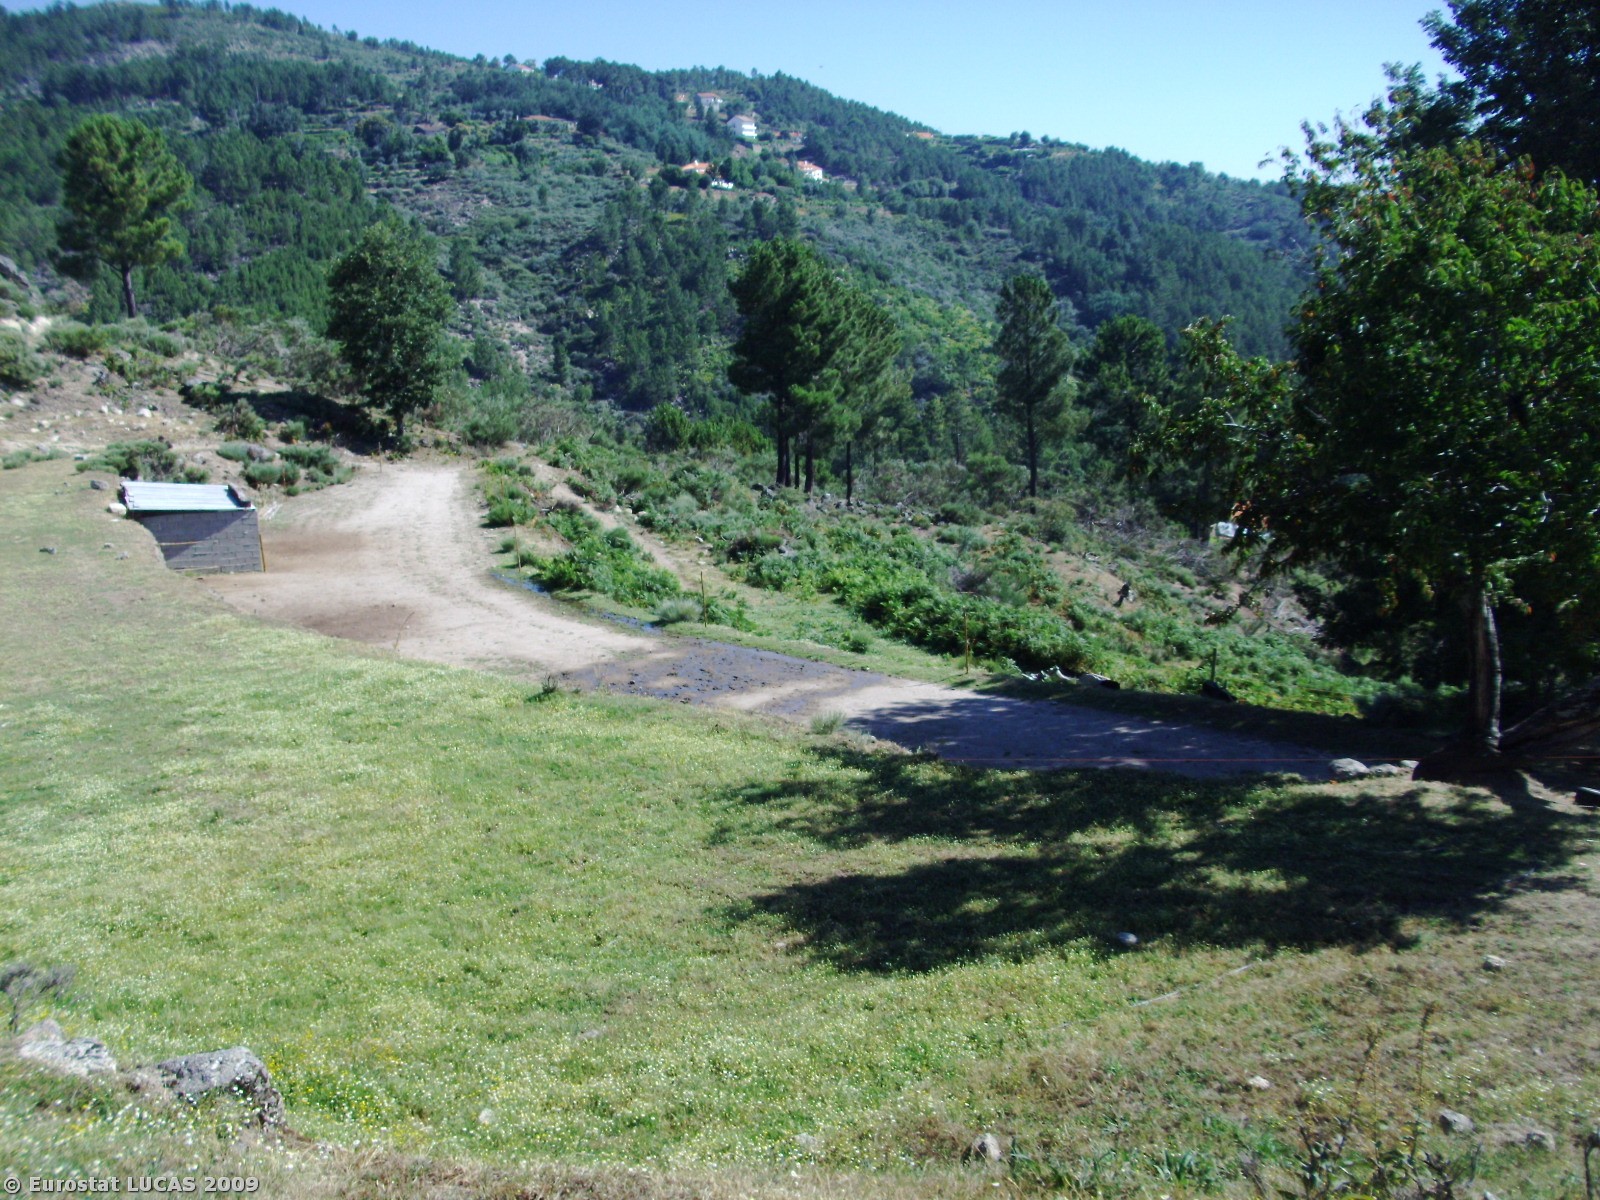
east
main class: Grassland
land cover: Spontaneously vegetated surfaces
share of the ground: > 75 %
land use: Fallow land
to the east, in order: Spontaneously vegetated surfaces; Fences; Spontaneously vegetated surfaces; Fences; Spontaneously vegetated surfaces; Arable land (only in case pi); Broadleaved woodland; Arable land (only in case pi); Broadleaved woodland; Arable land (only in case pi); Broadleaved woodland; Arable land (only in case pi)
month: July
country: PT
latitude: 40.2640
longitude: -7.5221
